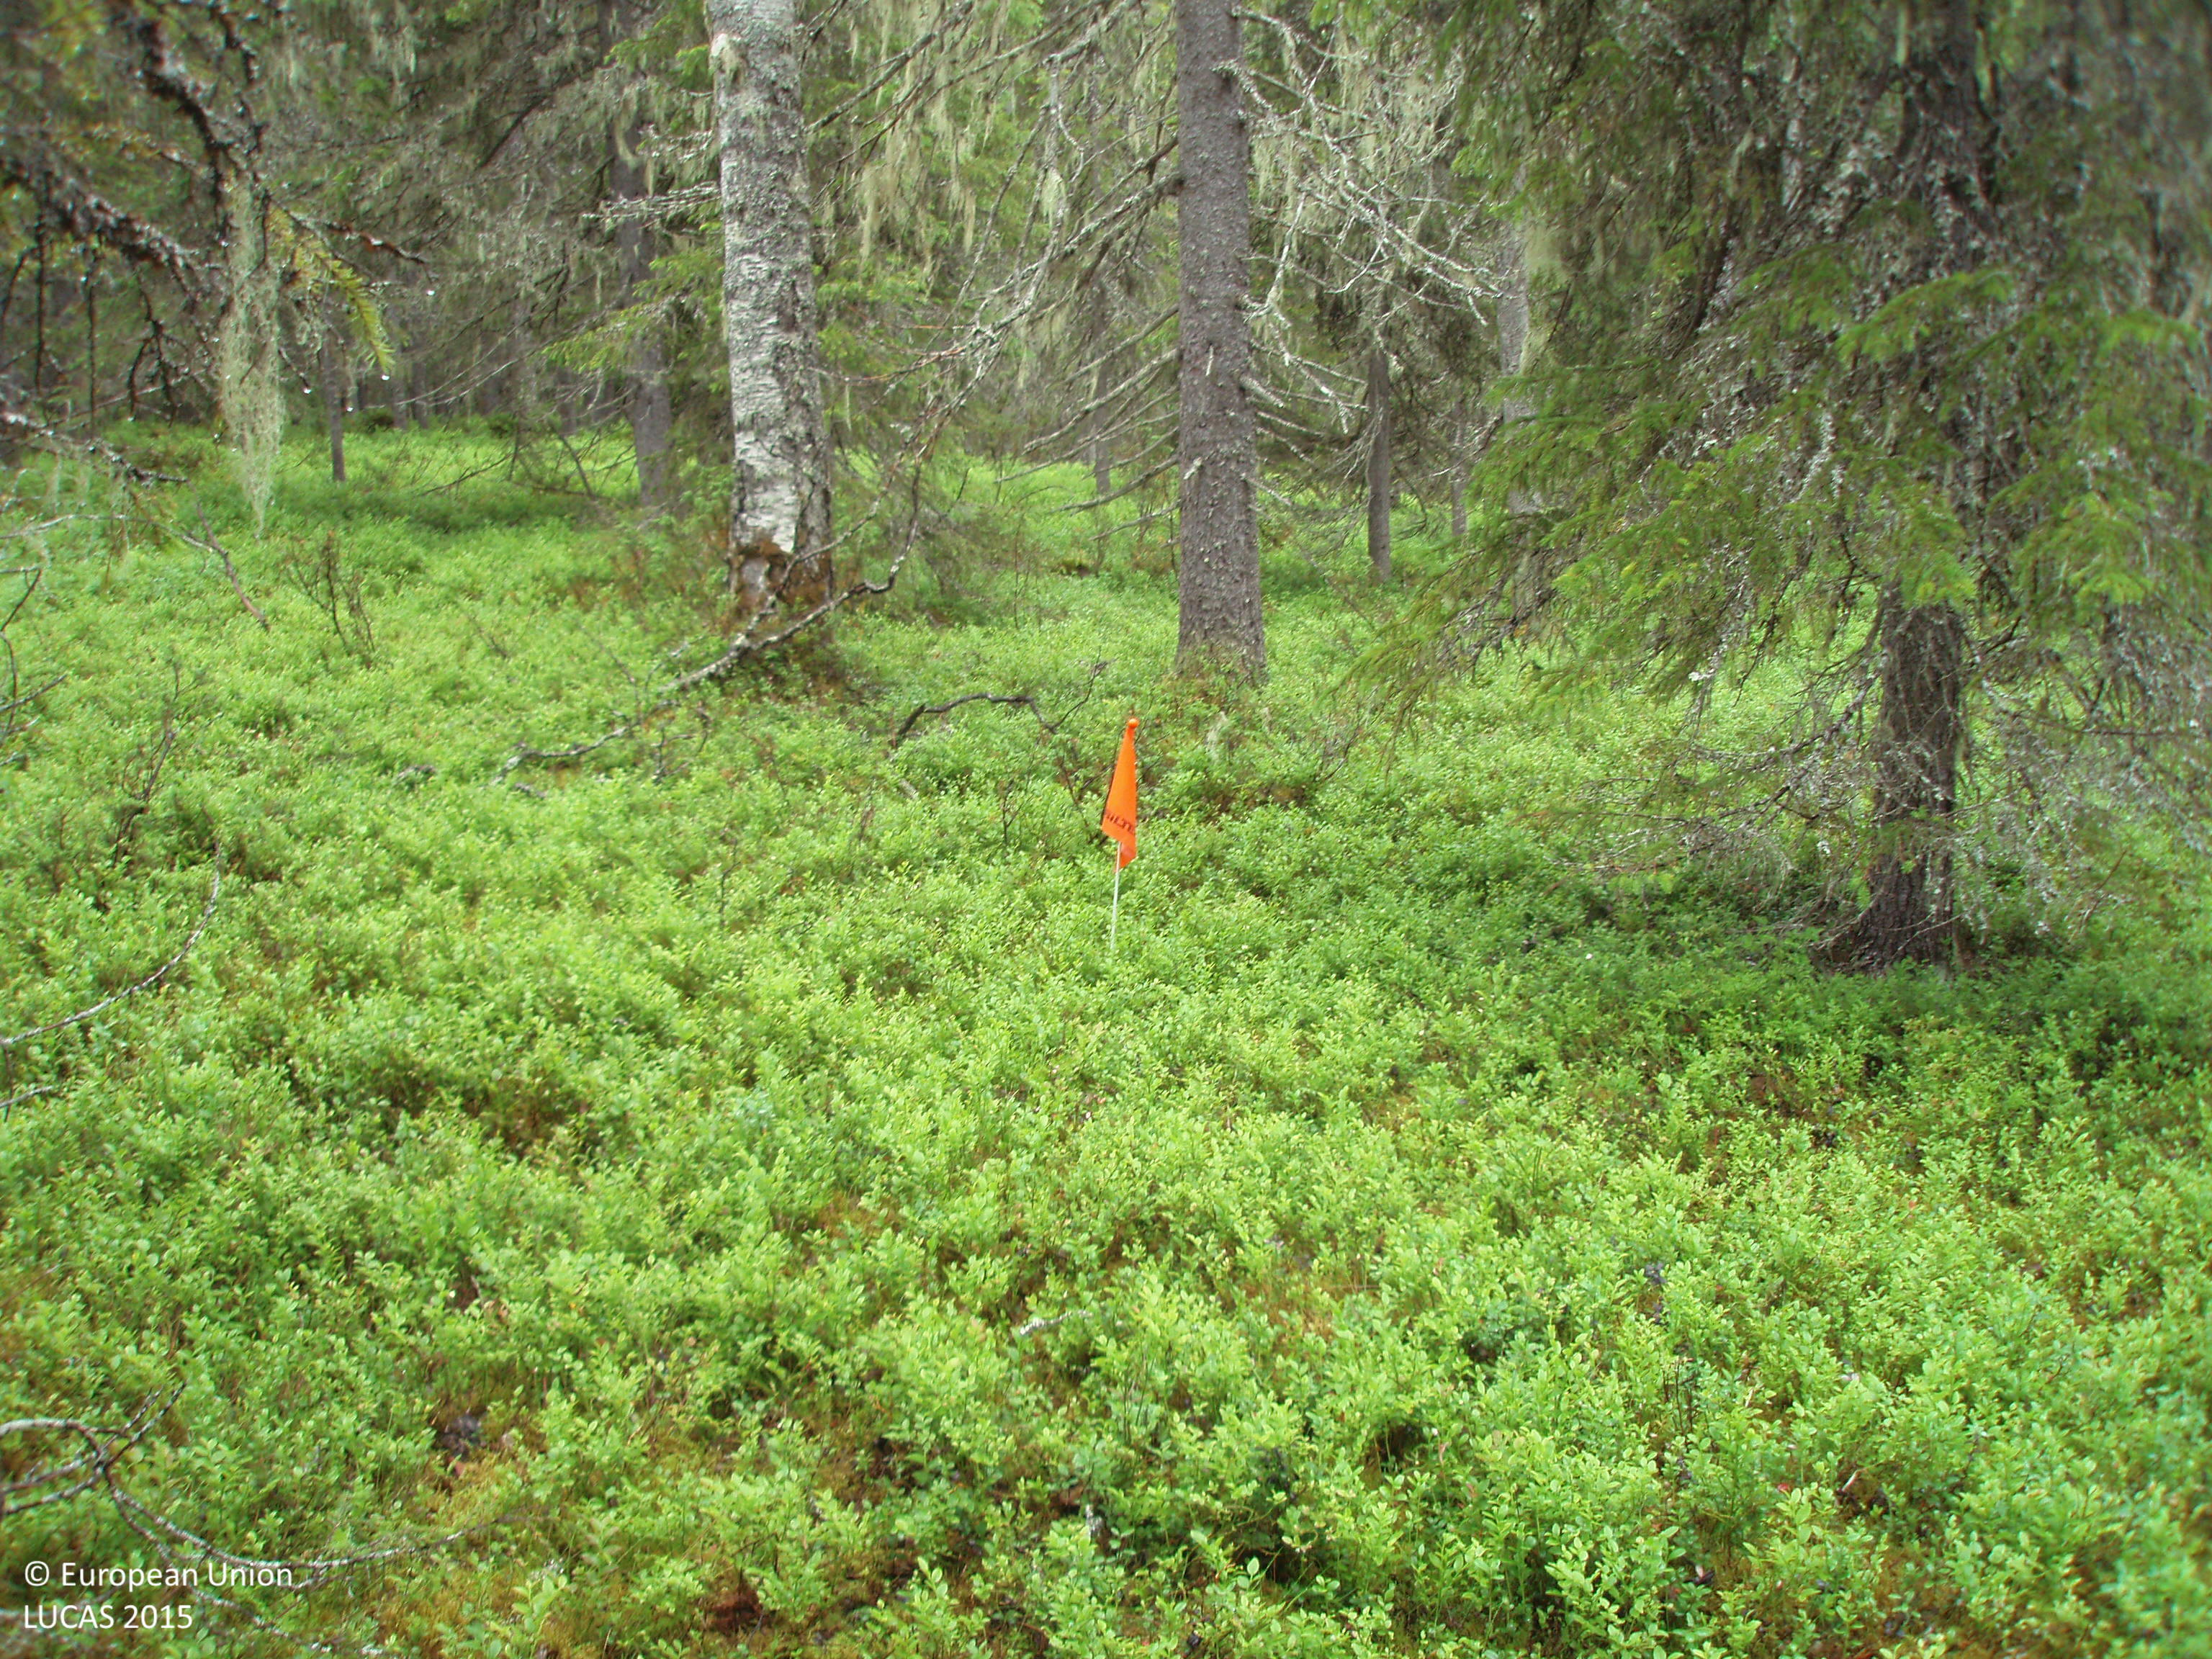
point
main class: Woodland
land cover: Spruce dominated coniferous woodland
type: boreal forest
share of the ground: > 75 %
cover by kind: coniferous forest trees 75 %, shrubs 25 %
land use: Forestry
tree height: > 5 m
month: August
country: FI
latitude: 65.6226
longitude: 27.5651
